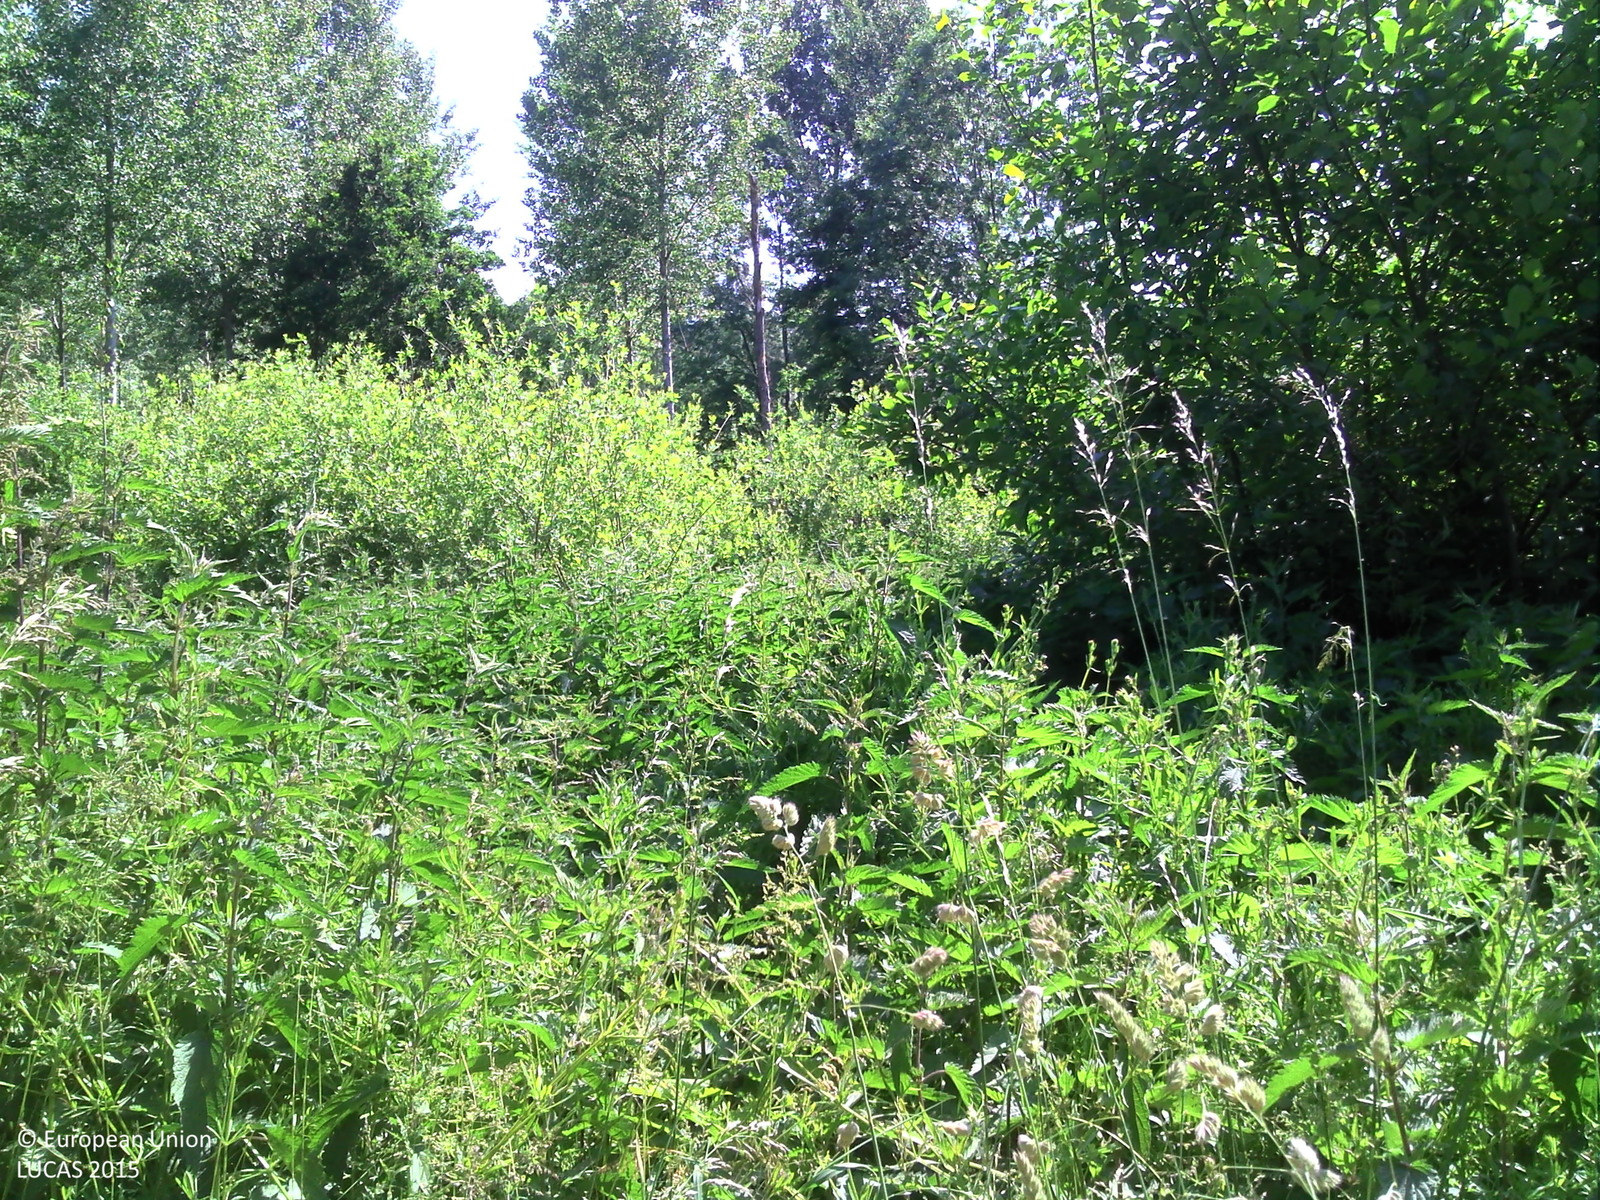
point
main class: Grassland
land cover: Spontaneously vegetated surfaces
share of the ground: > 75 %
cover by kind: herbaceous plants 100 %
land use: Semi-natural and natural areas not in use
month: June
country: BE
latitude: 50.8158
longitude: 5.4988
